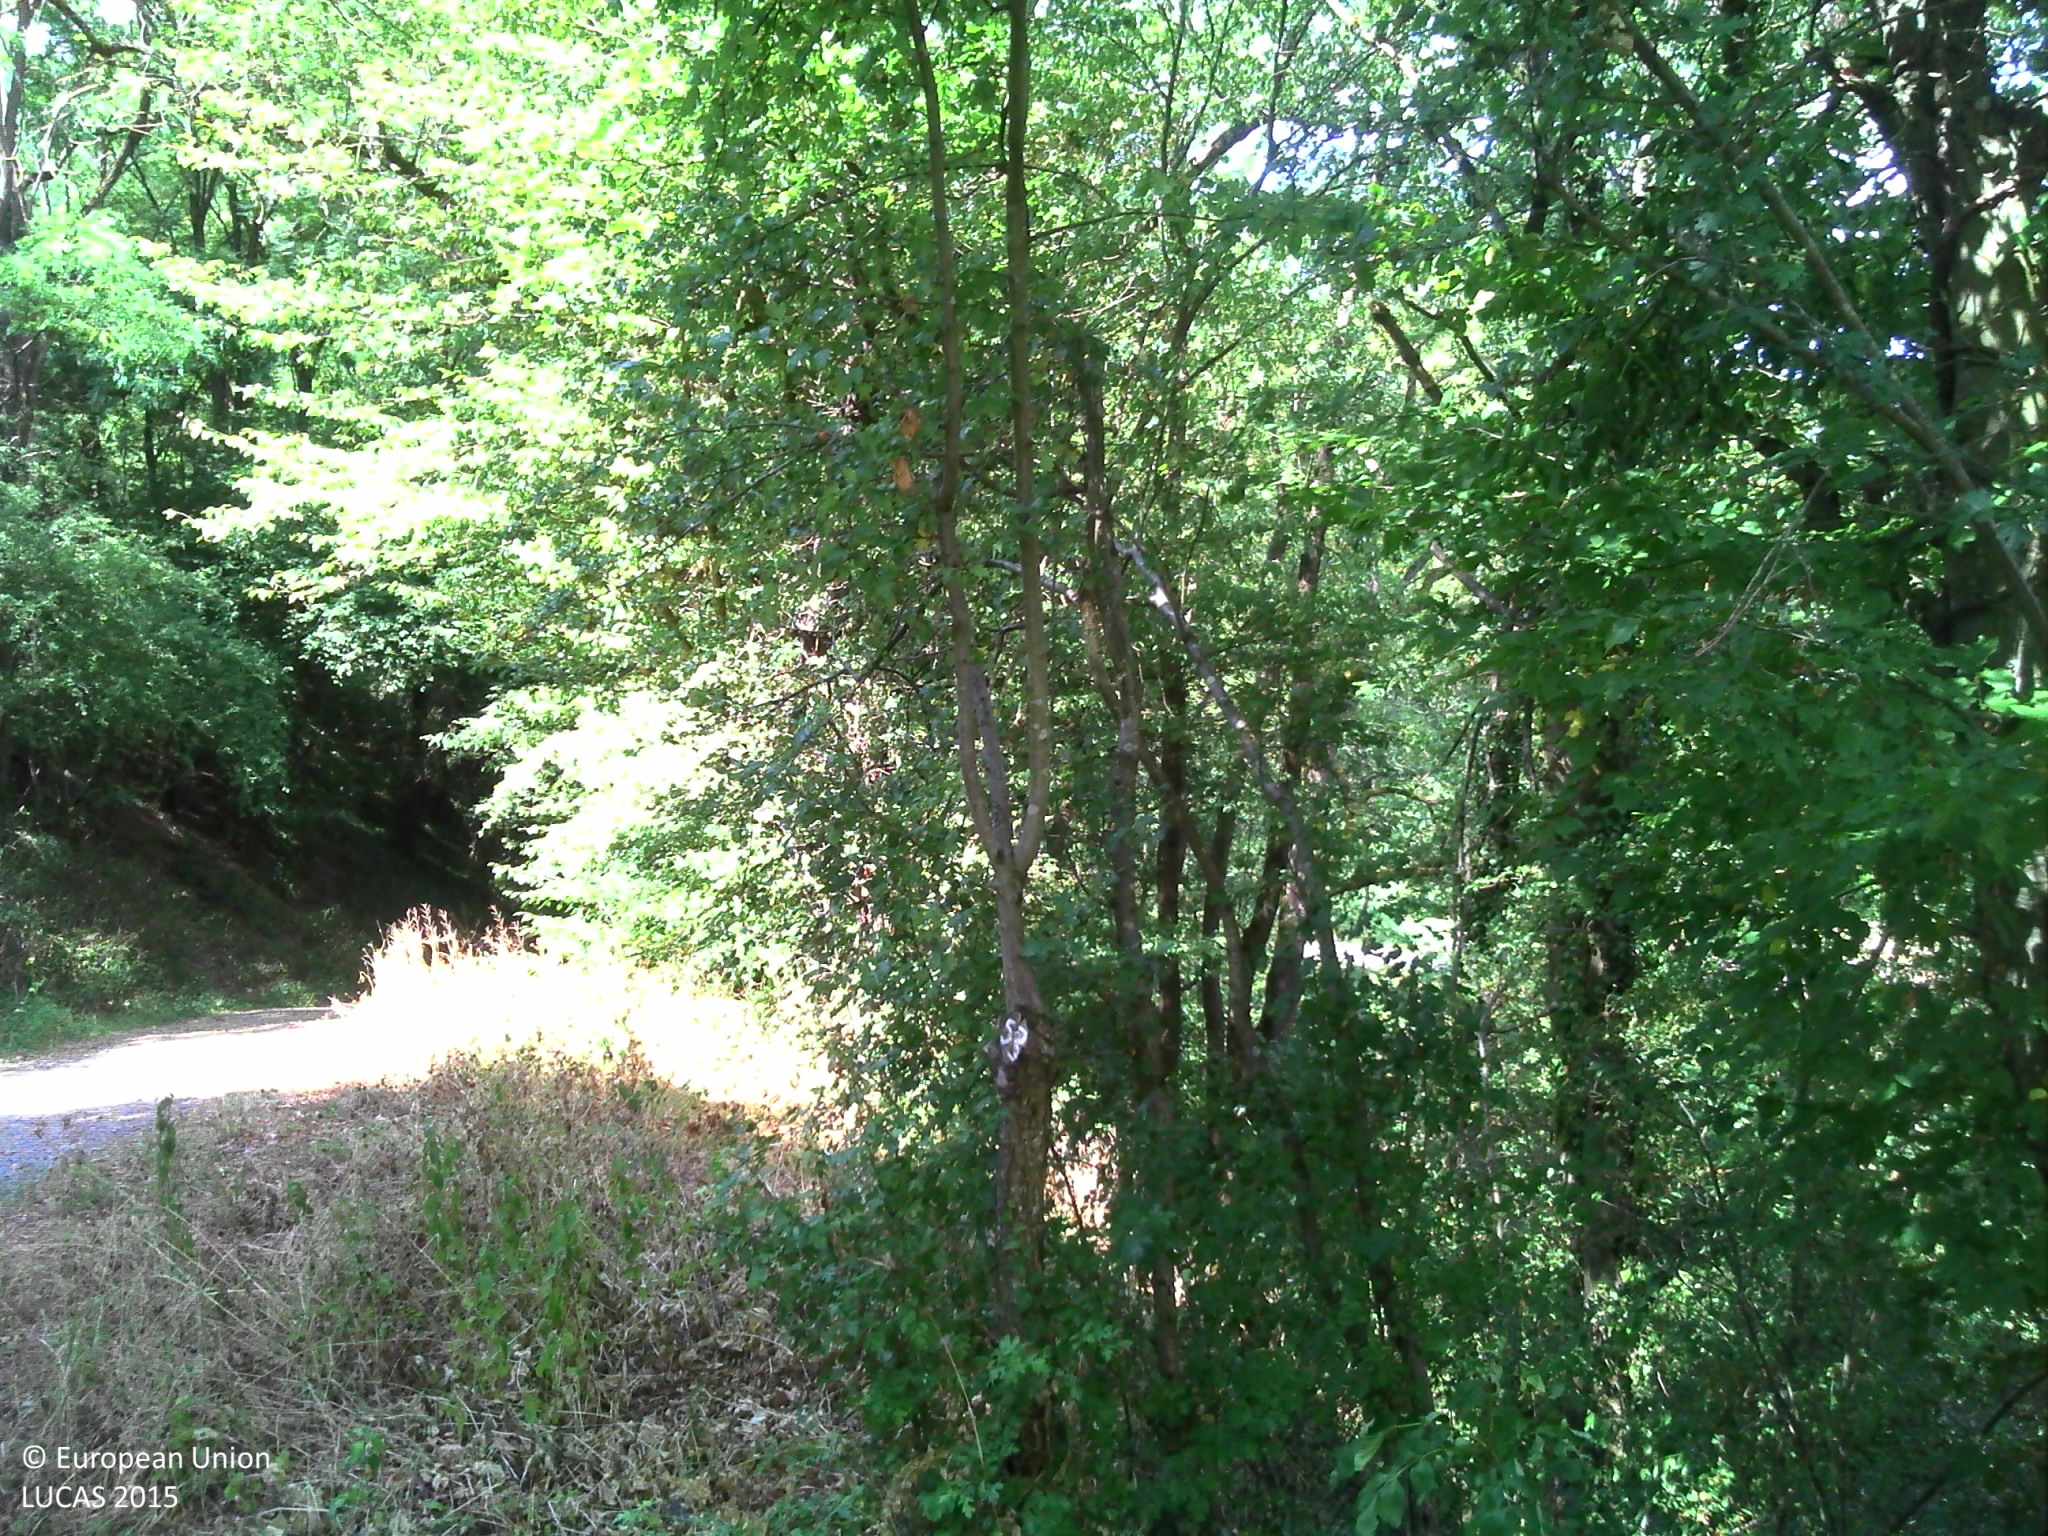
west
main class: Woodland
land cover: Broadleaved woodland
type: mesophytic deciduous forest
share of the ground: > 75 %
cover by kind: broadleaved forest trees 100 %
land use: Community services
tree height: > 5 m
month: July
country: FR
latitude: 45.8362
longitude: 4.6087
